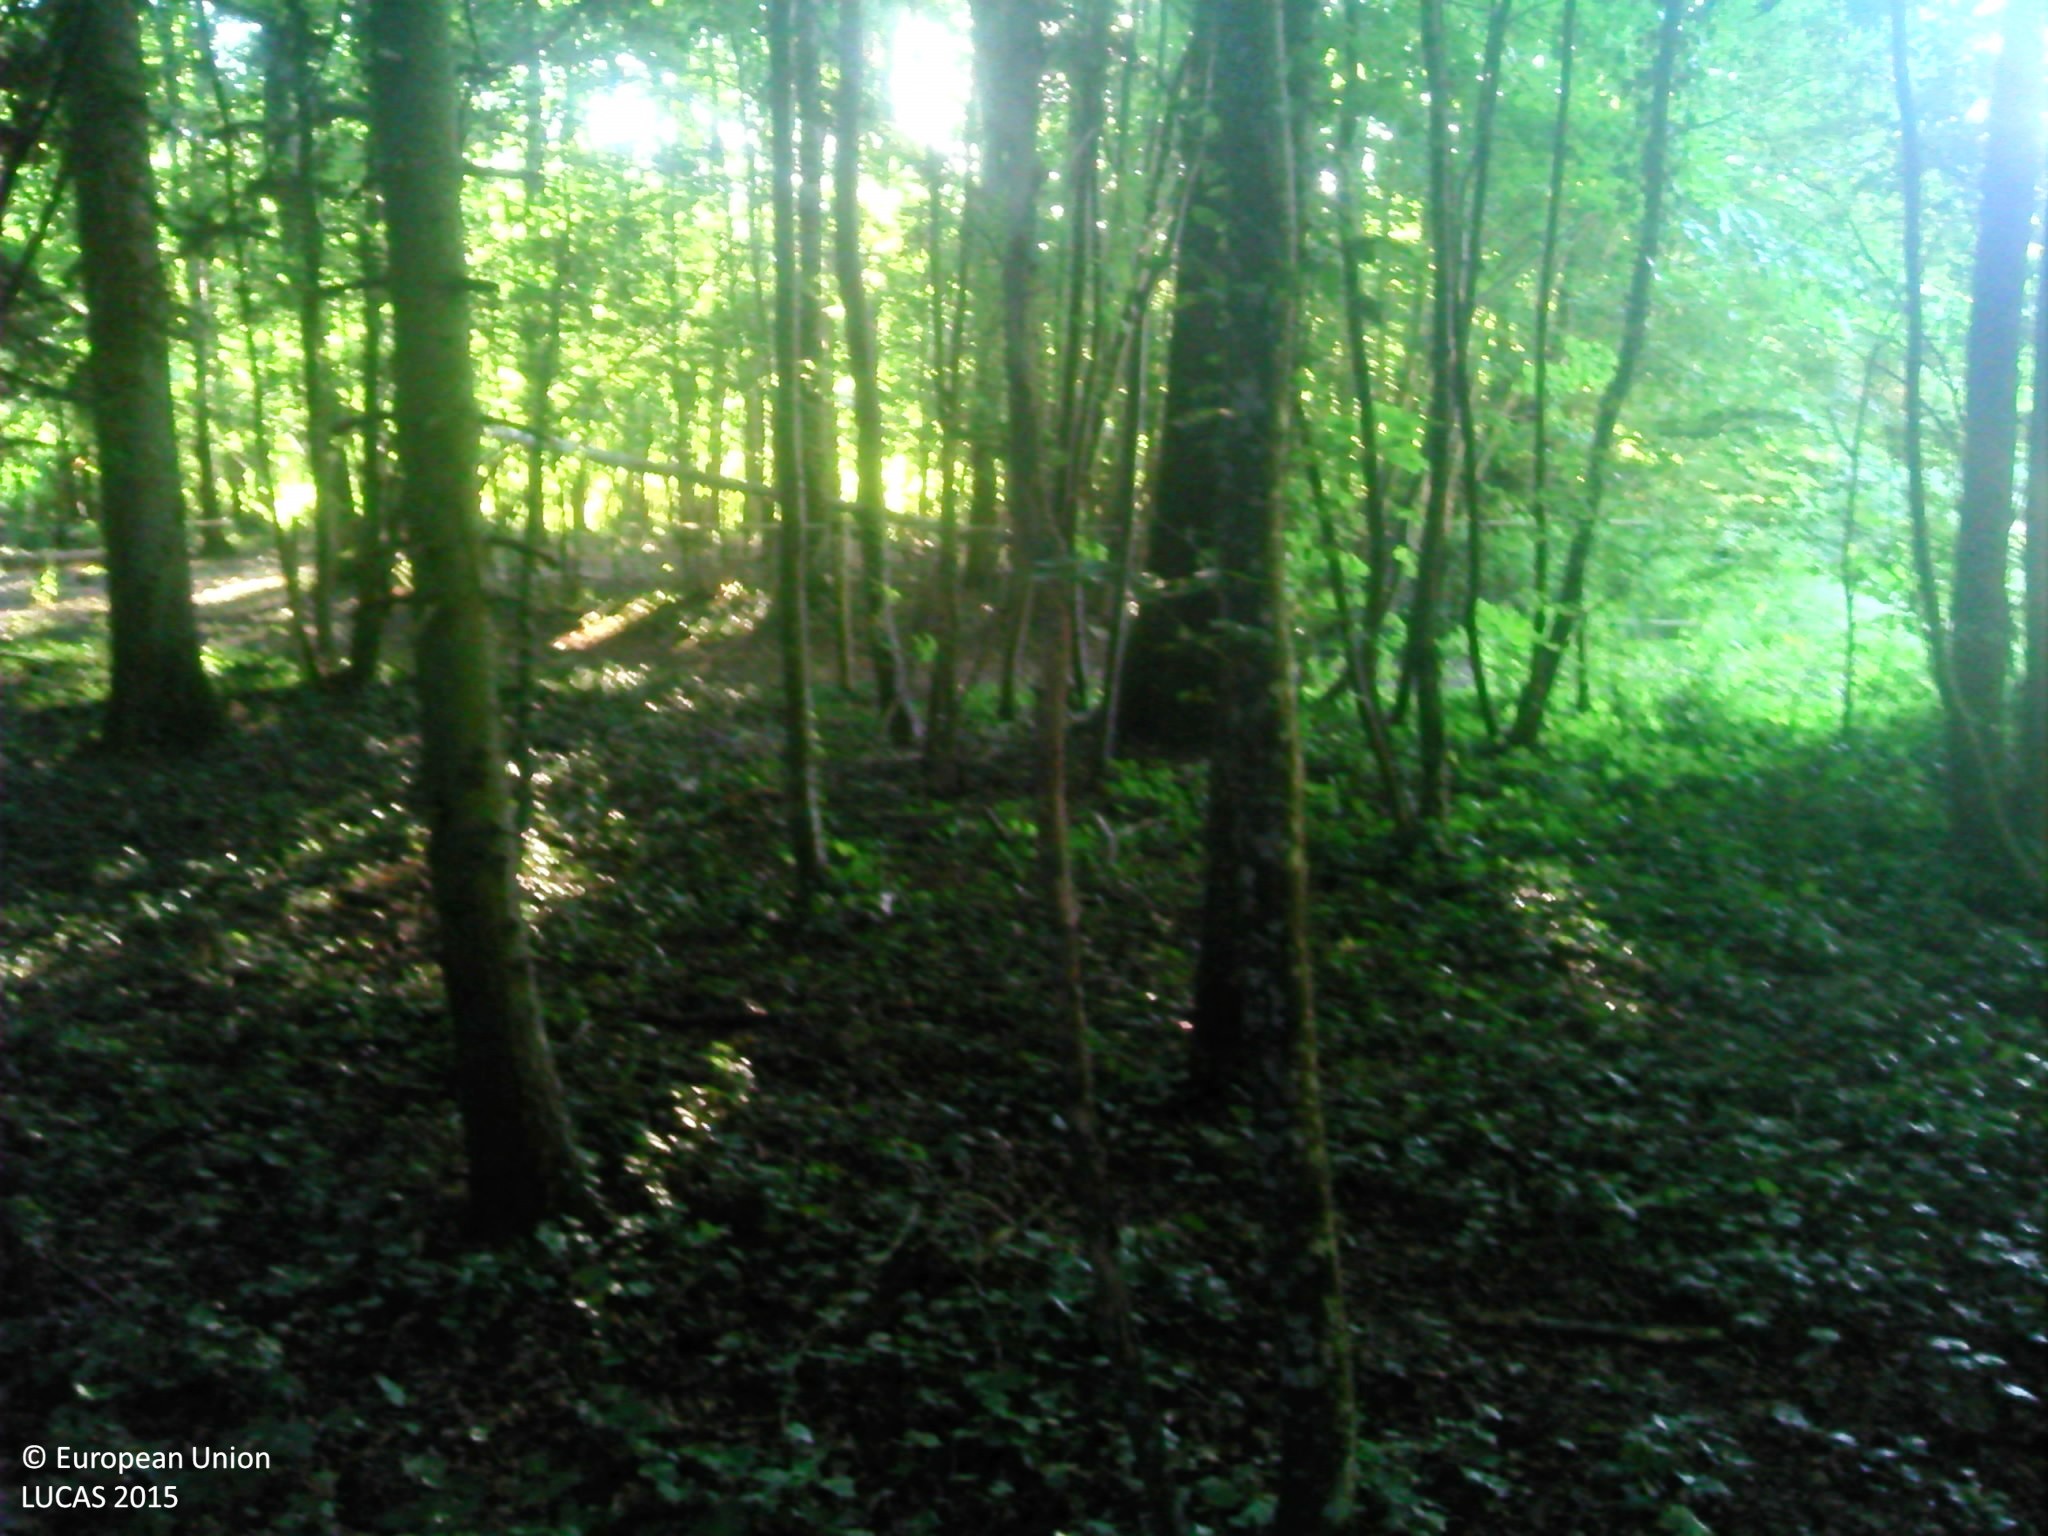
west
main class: Woodland
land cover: Broadleaved woodland
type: mesophytic deciduous forest
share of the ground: > 75 %
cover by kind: unconsolidated bare surface 60 %, broadleaved forest trees 20 %, herbaceous plants 20 %
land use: Forestry
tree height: > 5 m
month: June
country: FR
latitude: 47.2345
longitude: 1.3873
